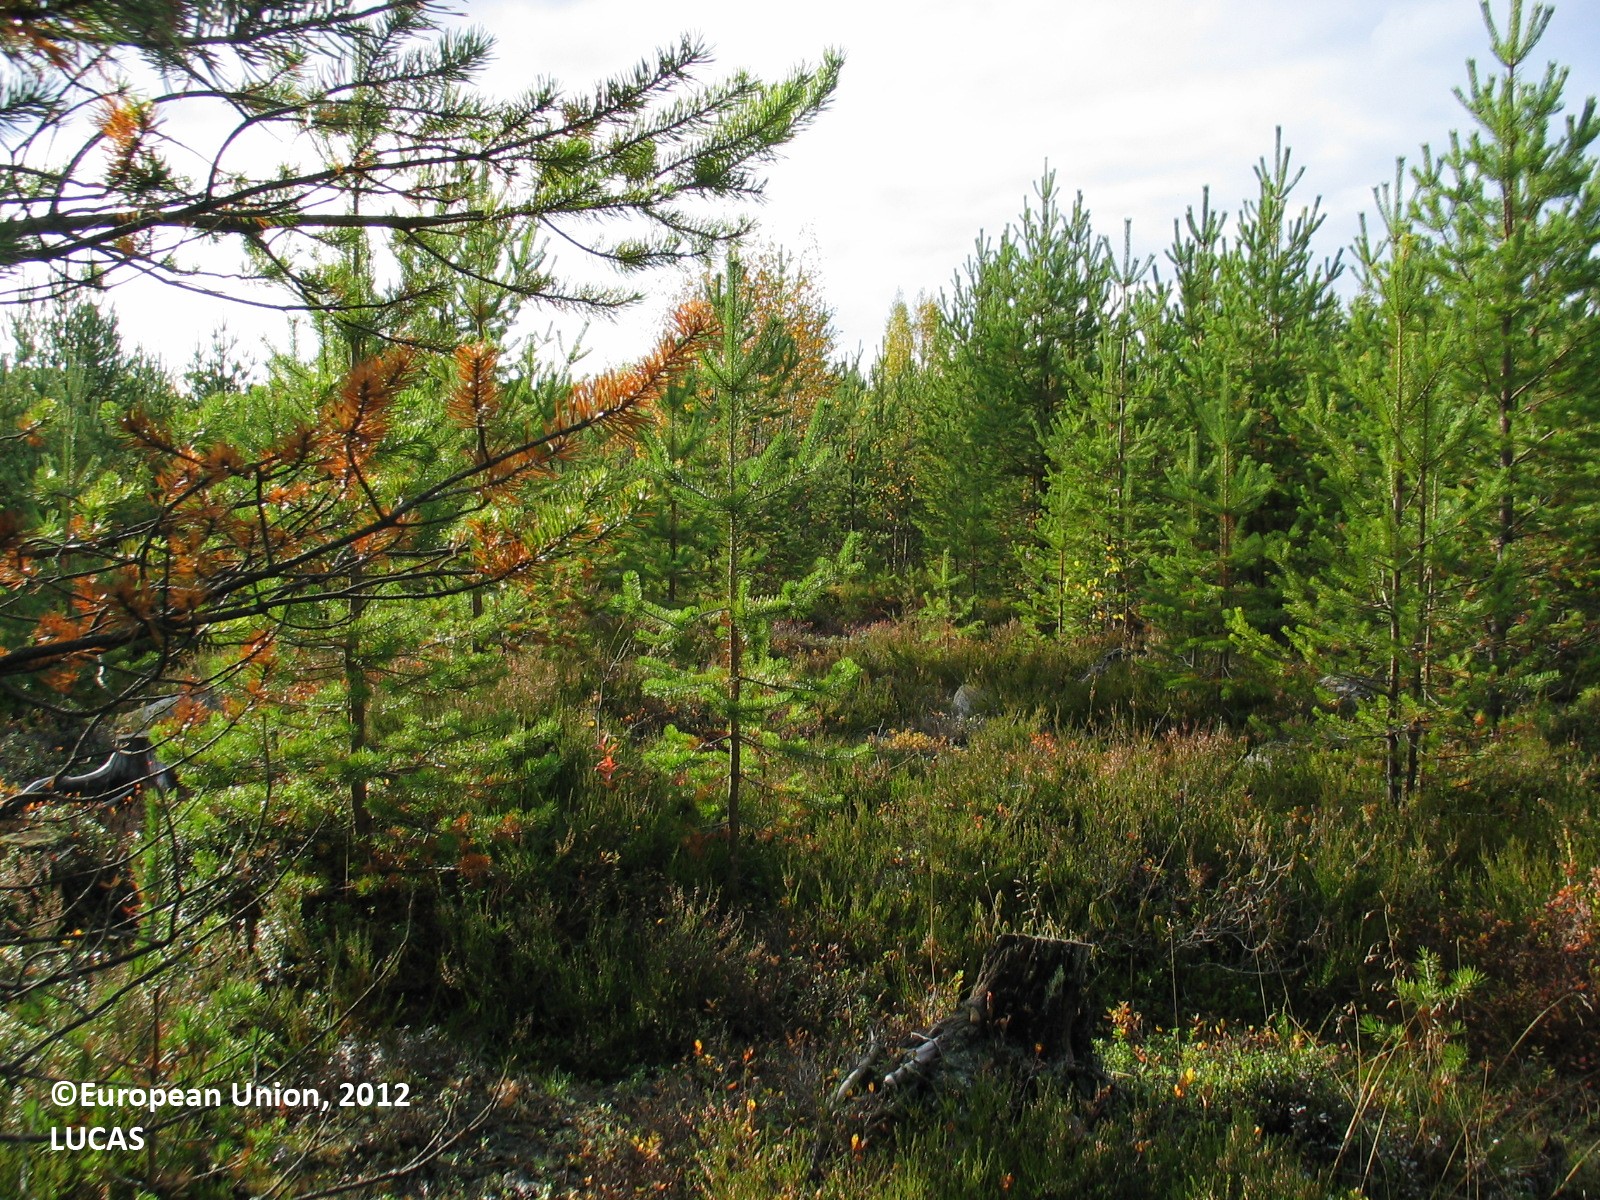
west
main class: Woodland
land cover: Pine dominated coniferous woodland
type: boreal forest
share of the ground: 25 - 50 %
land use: Forestry
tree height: < 5 m
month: September
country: FI
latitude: 65.3744
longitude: 25.6323
